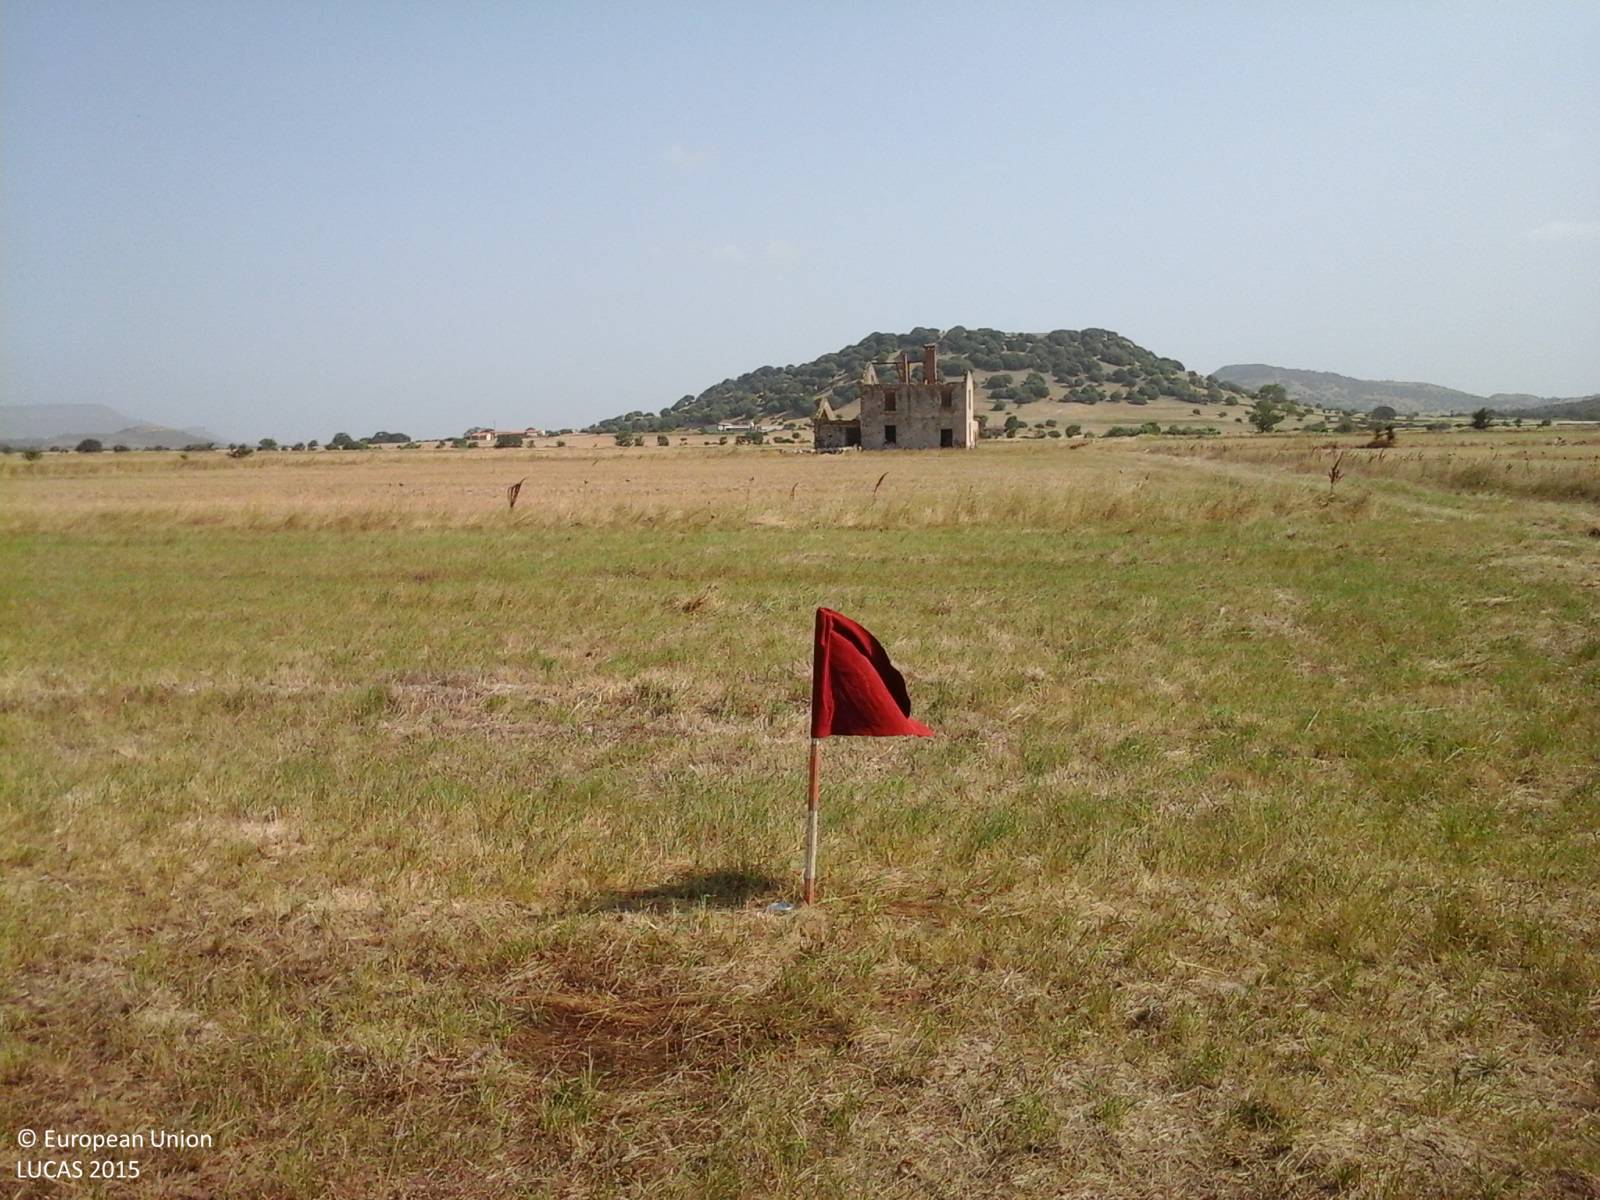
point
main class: Grassland
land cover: Grassland without tree/shrub cover
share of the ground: < 10 %
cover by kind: herbaceous plants 100 %
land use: Agriculture (excluding fallow land and kitchen gardens)
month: July
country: IT
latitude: 40.4593
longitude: 8.8149
